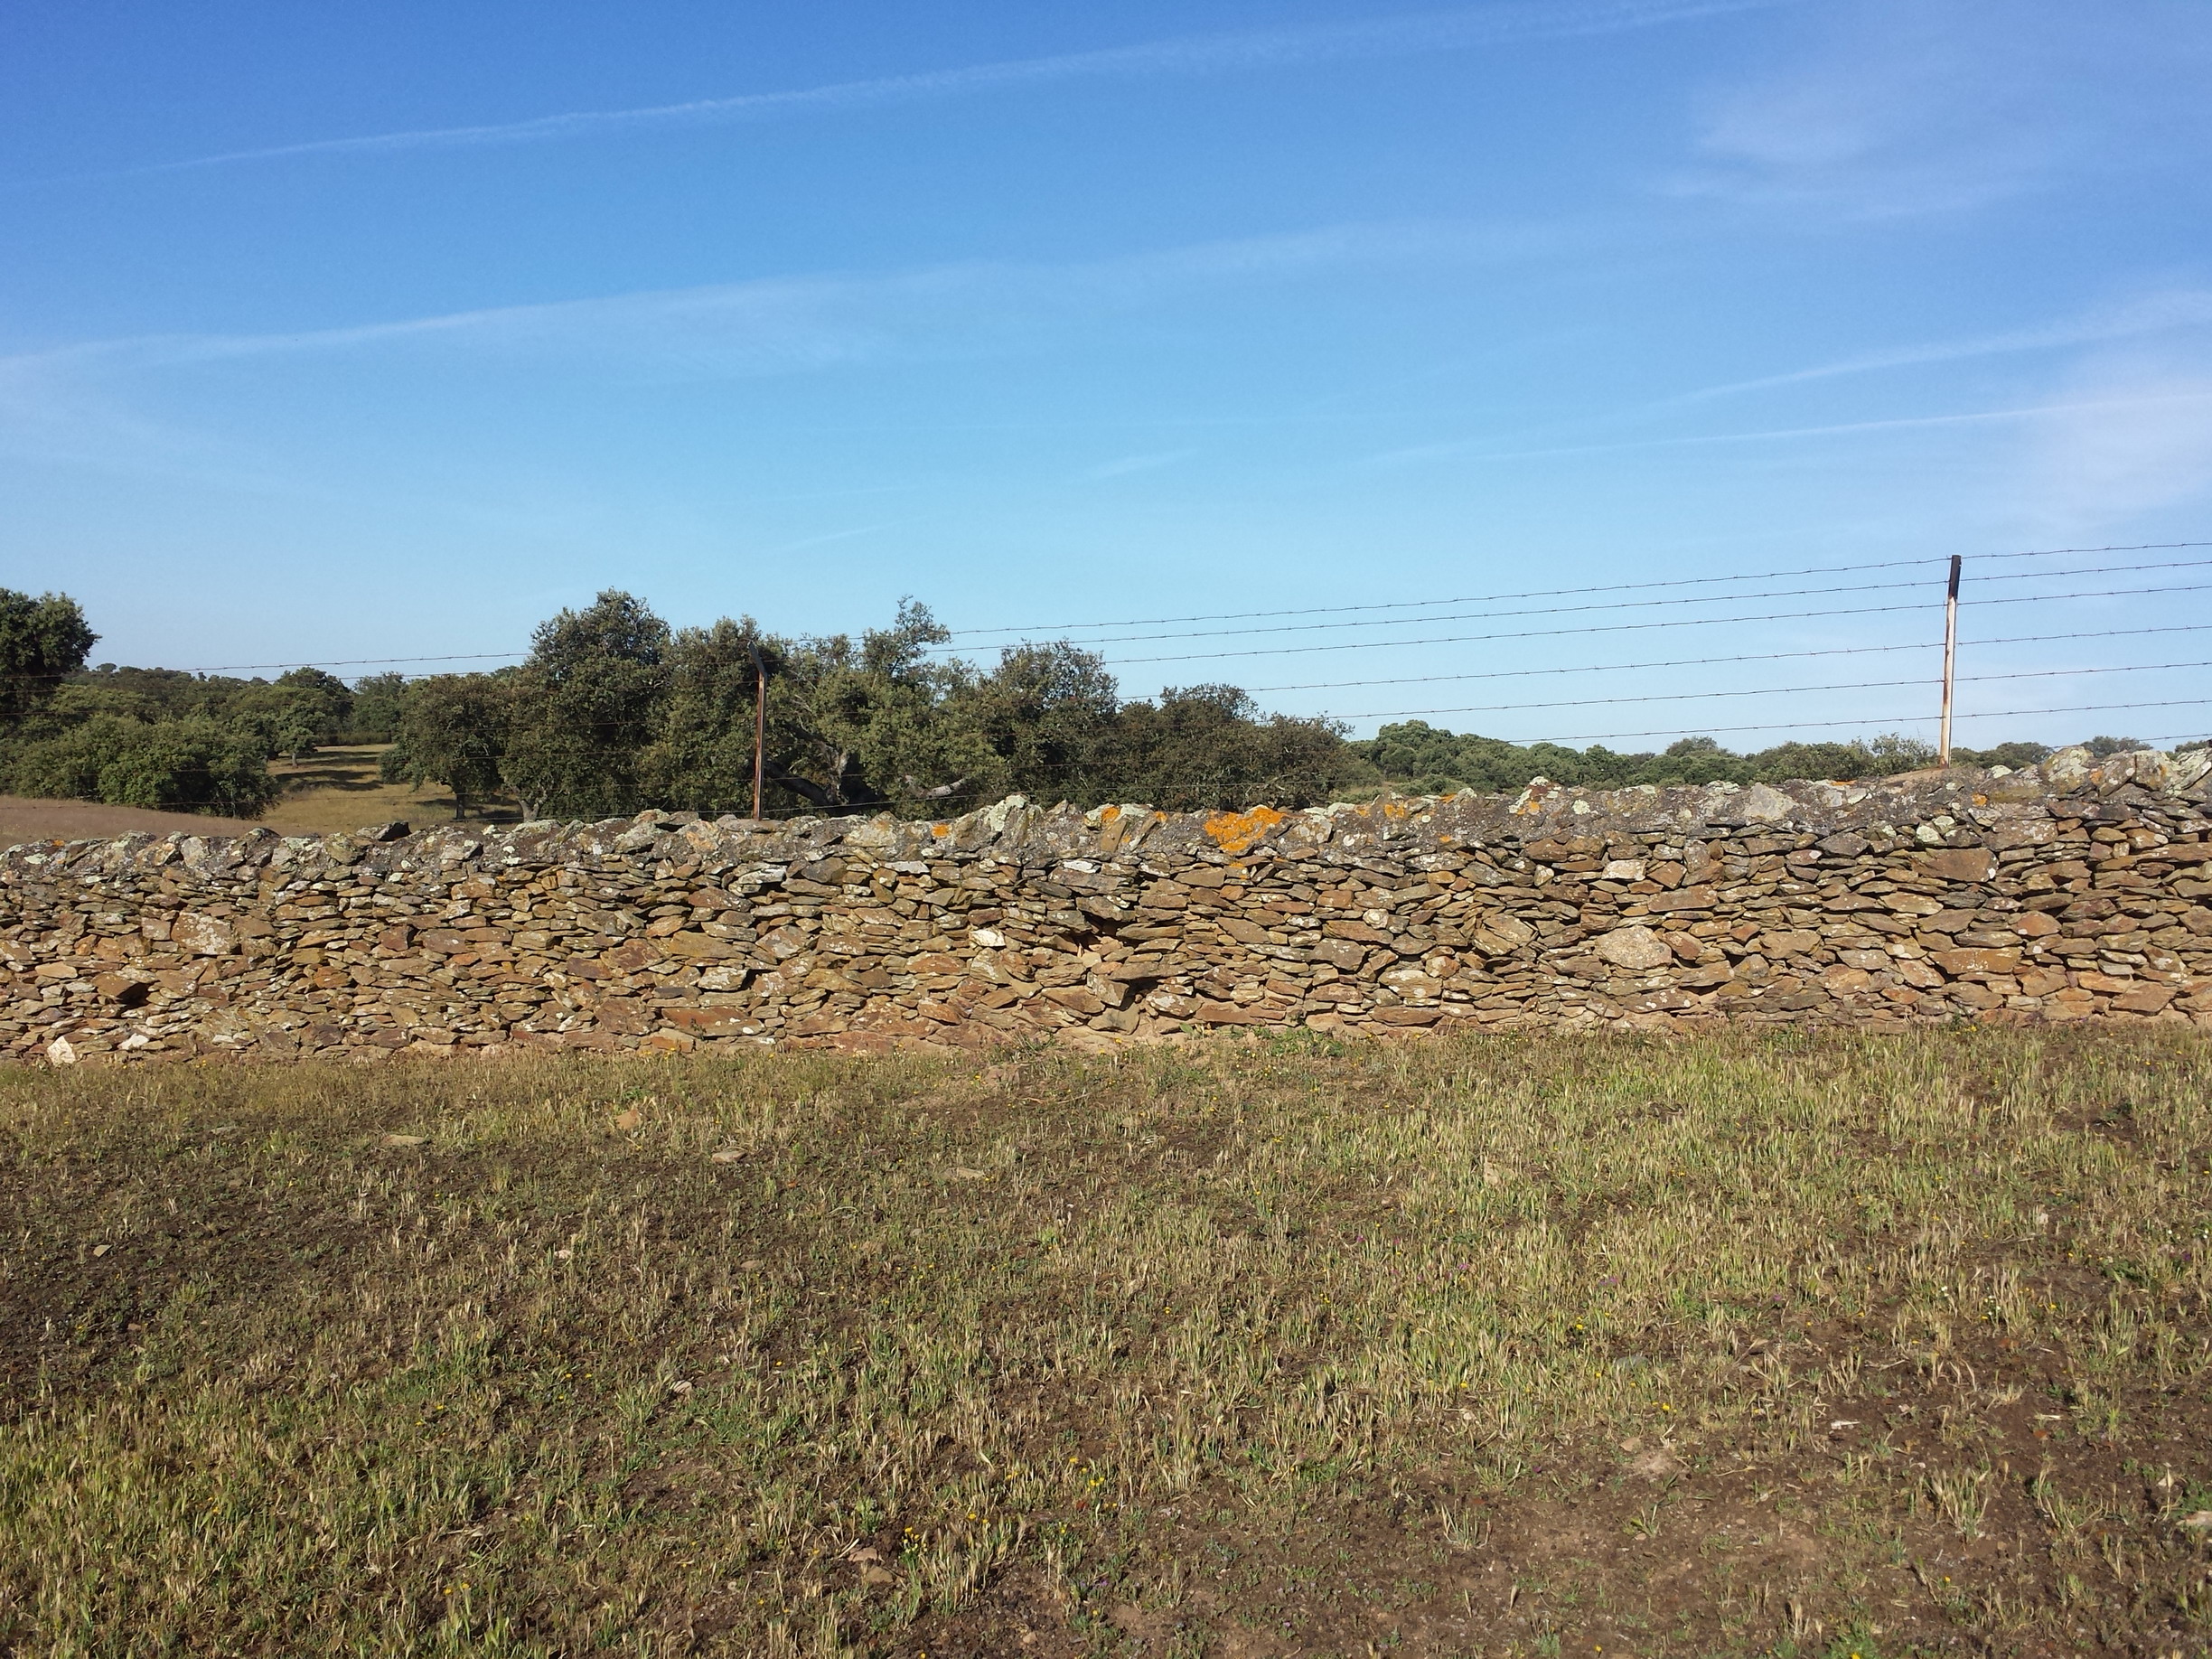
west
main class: Grassland
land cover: Grassland with sparse tree/shrub cover
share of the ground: > 75 %
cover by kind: herbaceous plants 90 %, broadleaved forest trees 5 %
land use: Agriculture (excluding fallow land and kitchen gardens)
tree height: > 5 m
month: May
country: ES
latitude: 39.6384
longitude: -7.2058
